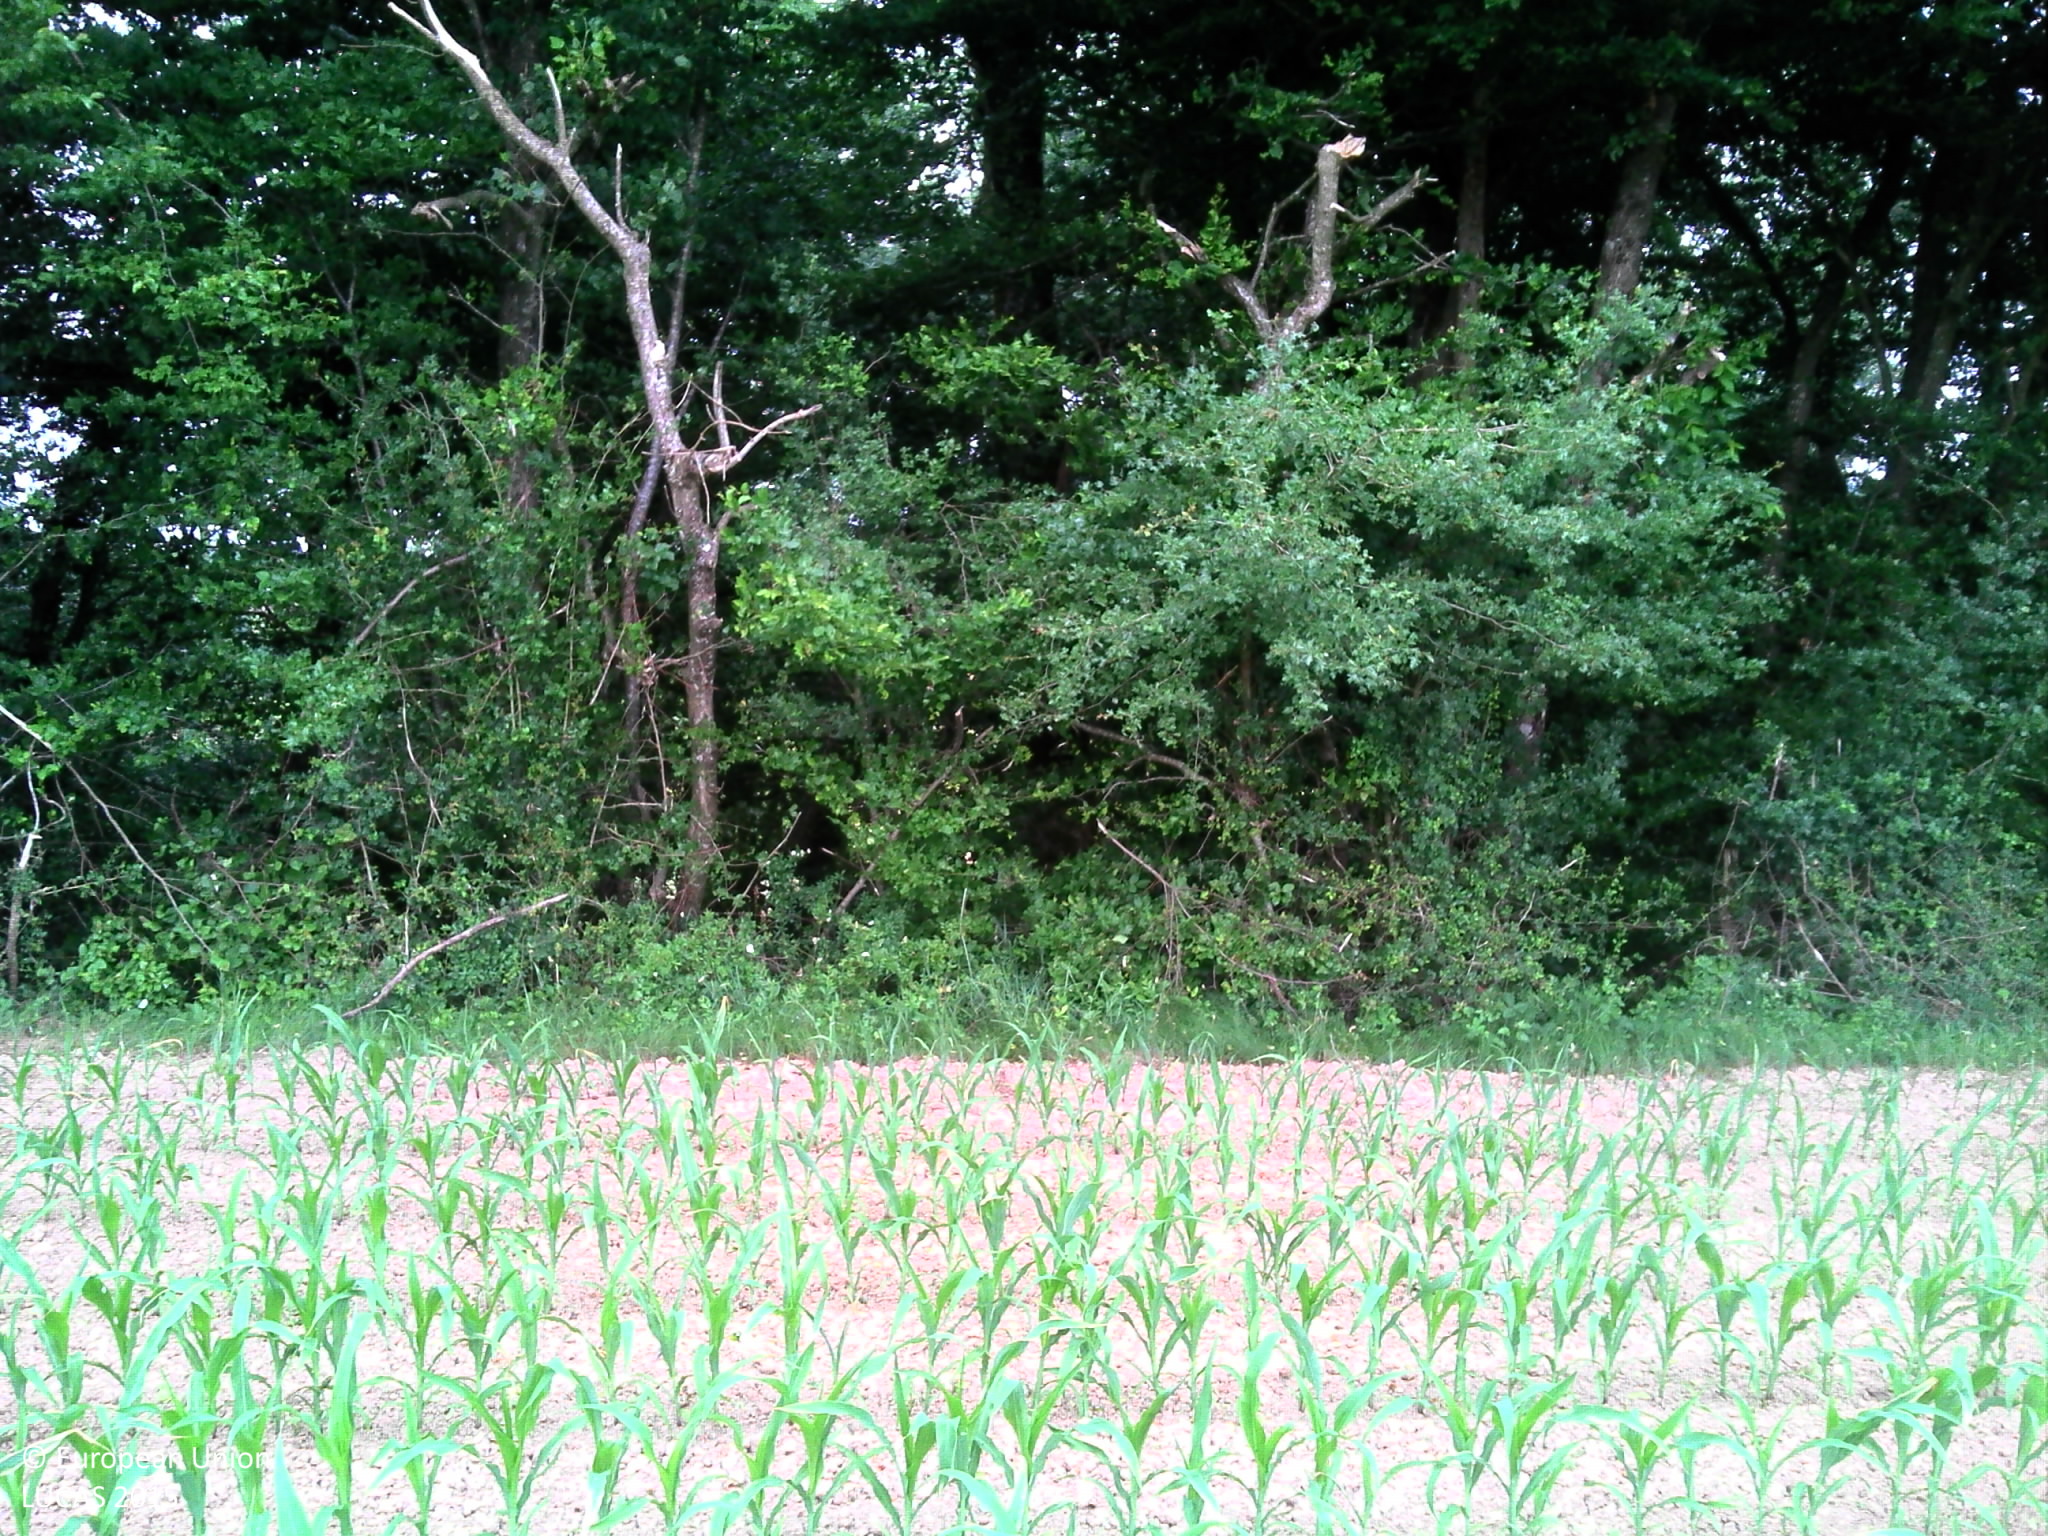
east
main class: Cropland
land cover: Maize
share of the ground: 50 - 75 %
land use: Agriculture (excluding fallow land and kitchen gardens)
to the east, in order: Maize; Grass margins; Fences; Broadleaved woodland; Inland fresh running water; Lines of trees; Common wheat; Grass margins; Ditches and canals; Grass margins; Sunflower
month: June
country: FR
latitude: 47.4768
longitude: 6.2994
